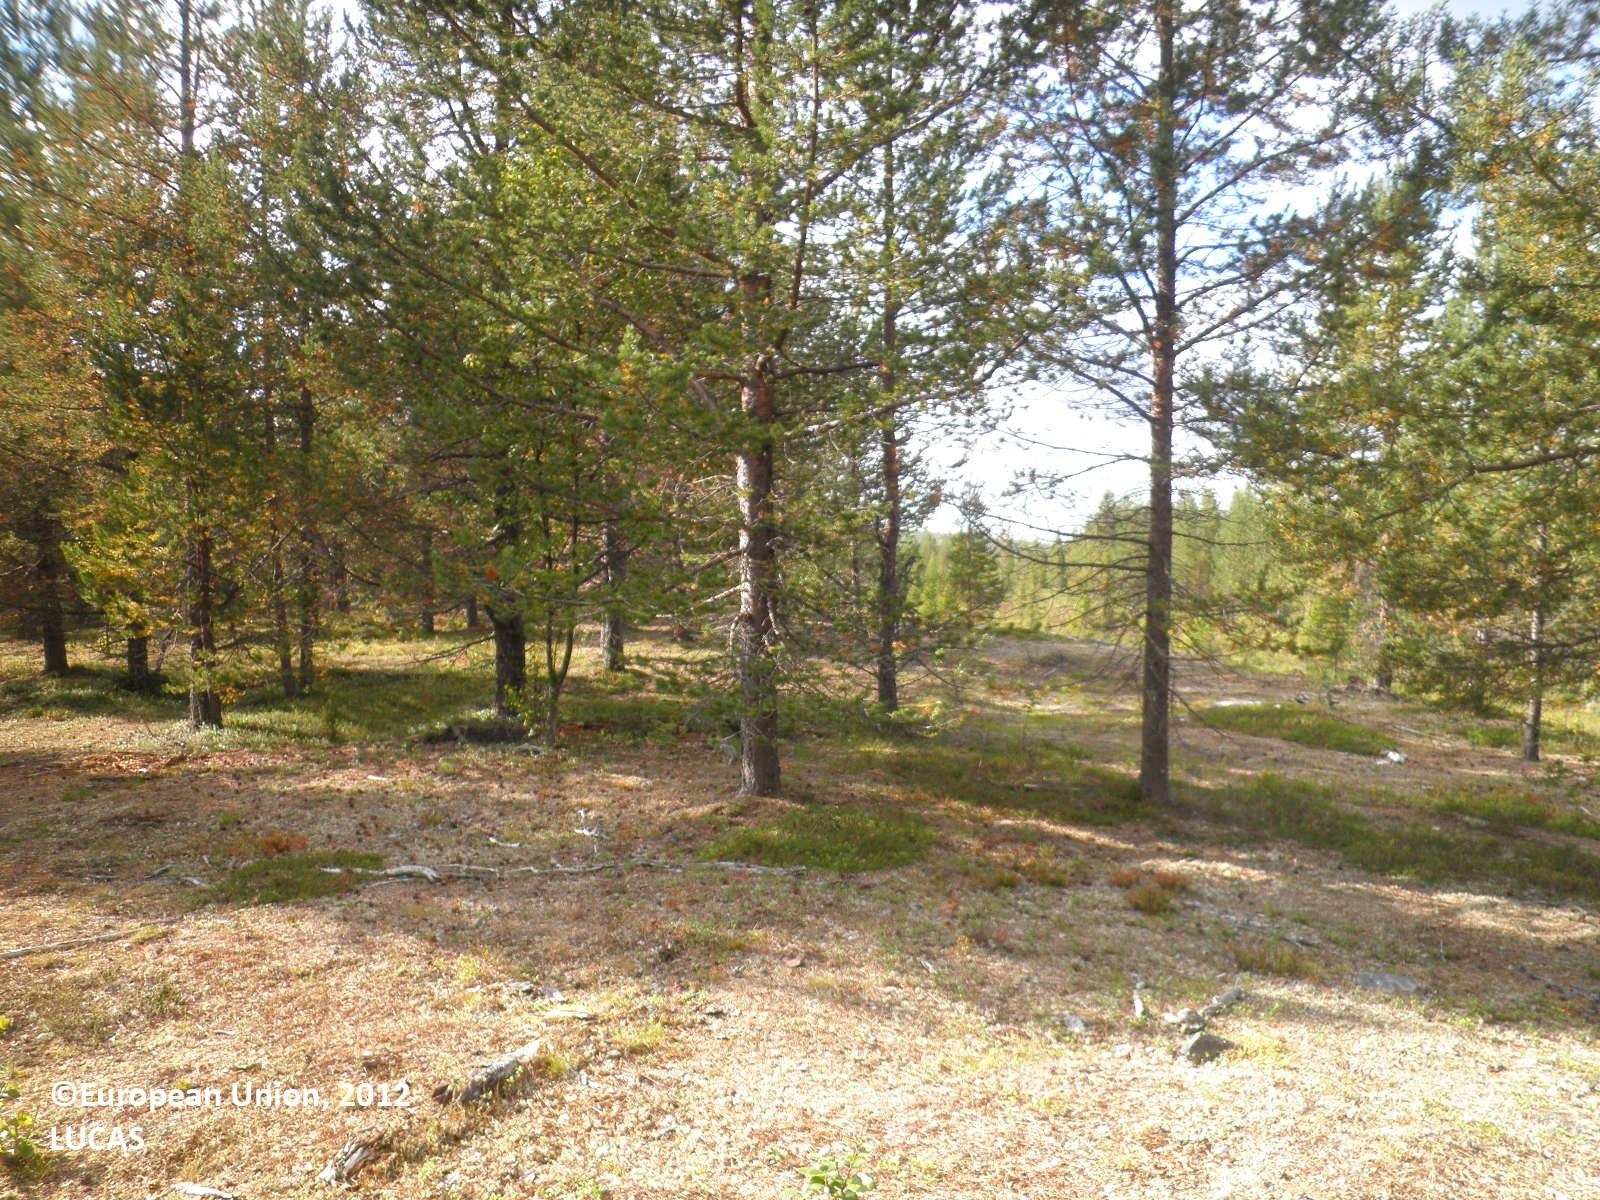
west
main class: Woodland
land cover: Pine dominated coniferous woodland
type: boreal forest
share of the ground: 25 - 50 %
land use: Forestry
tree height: > 5 m
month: August
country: FI
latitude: 67.5951
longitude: 29.9031
